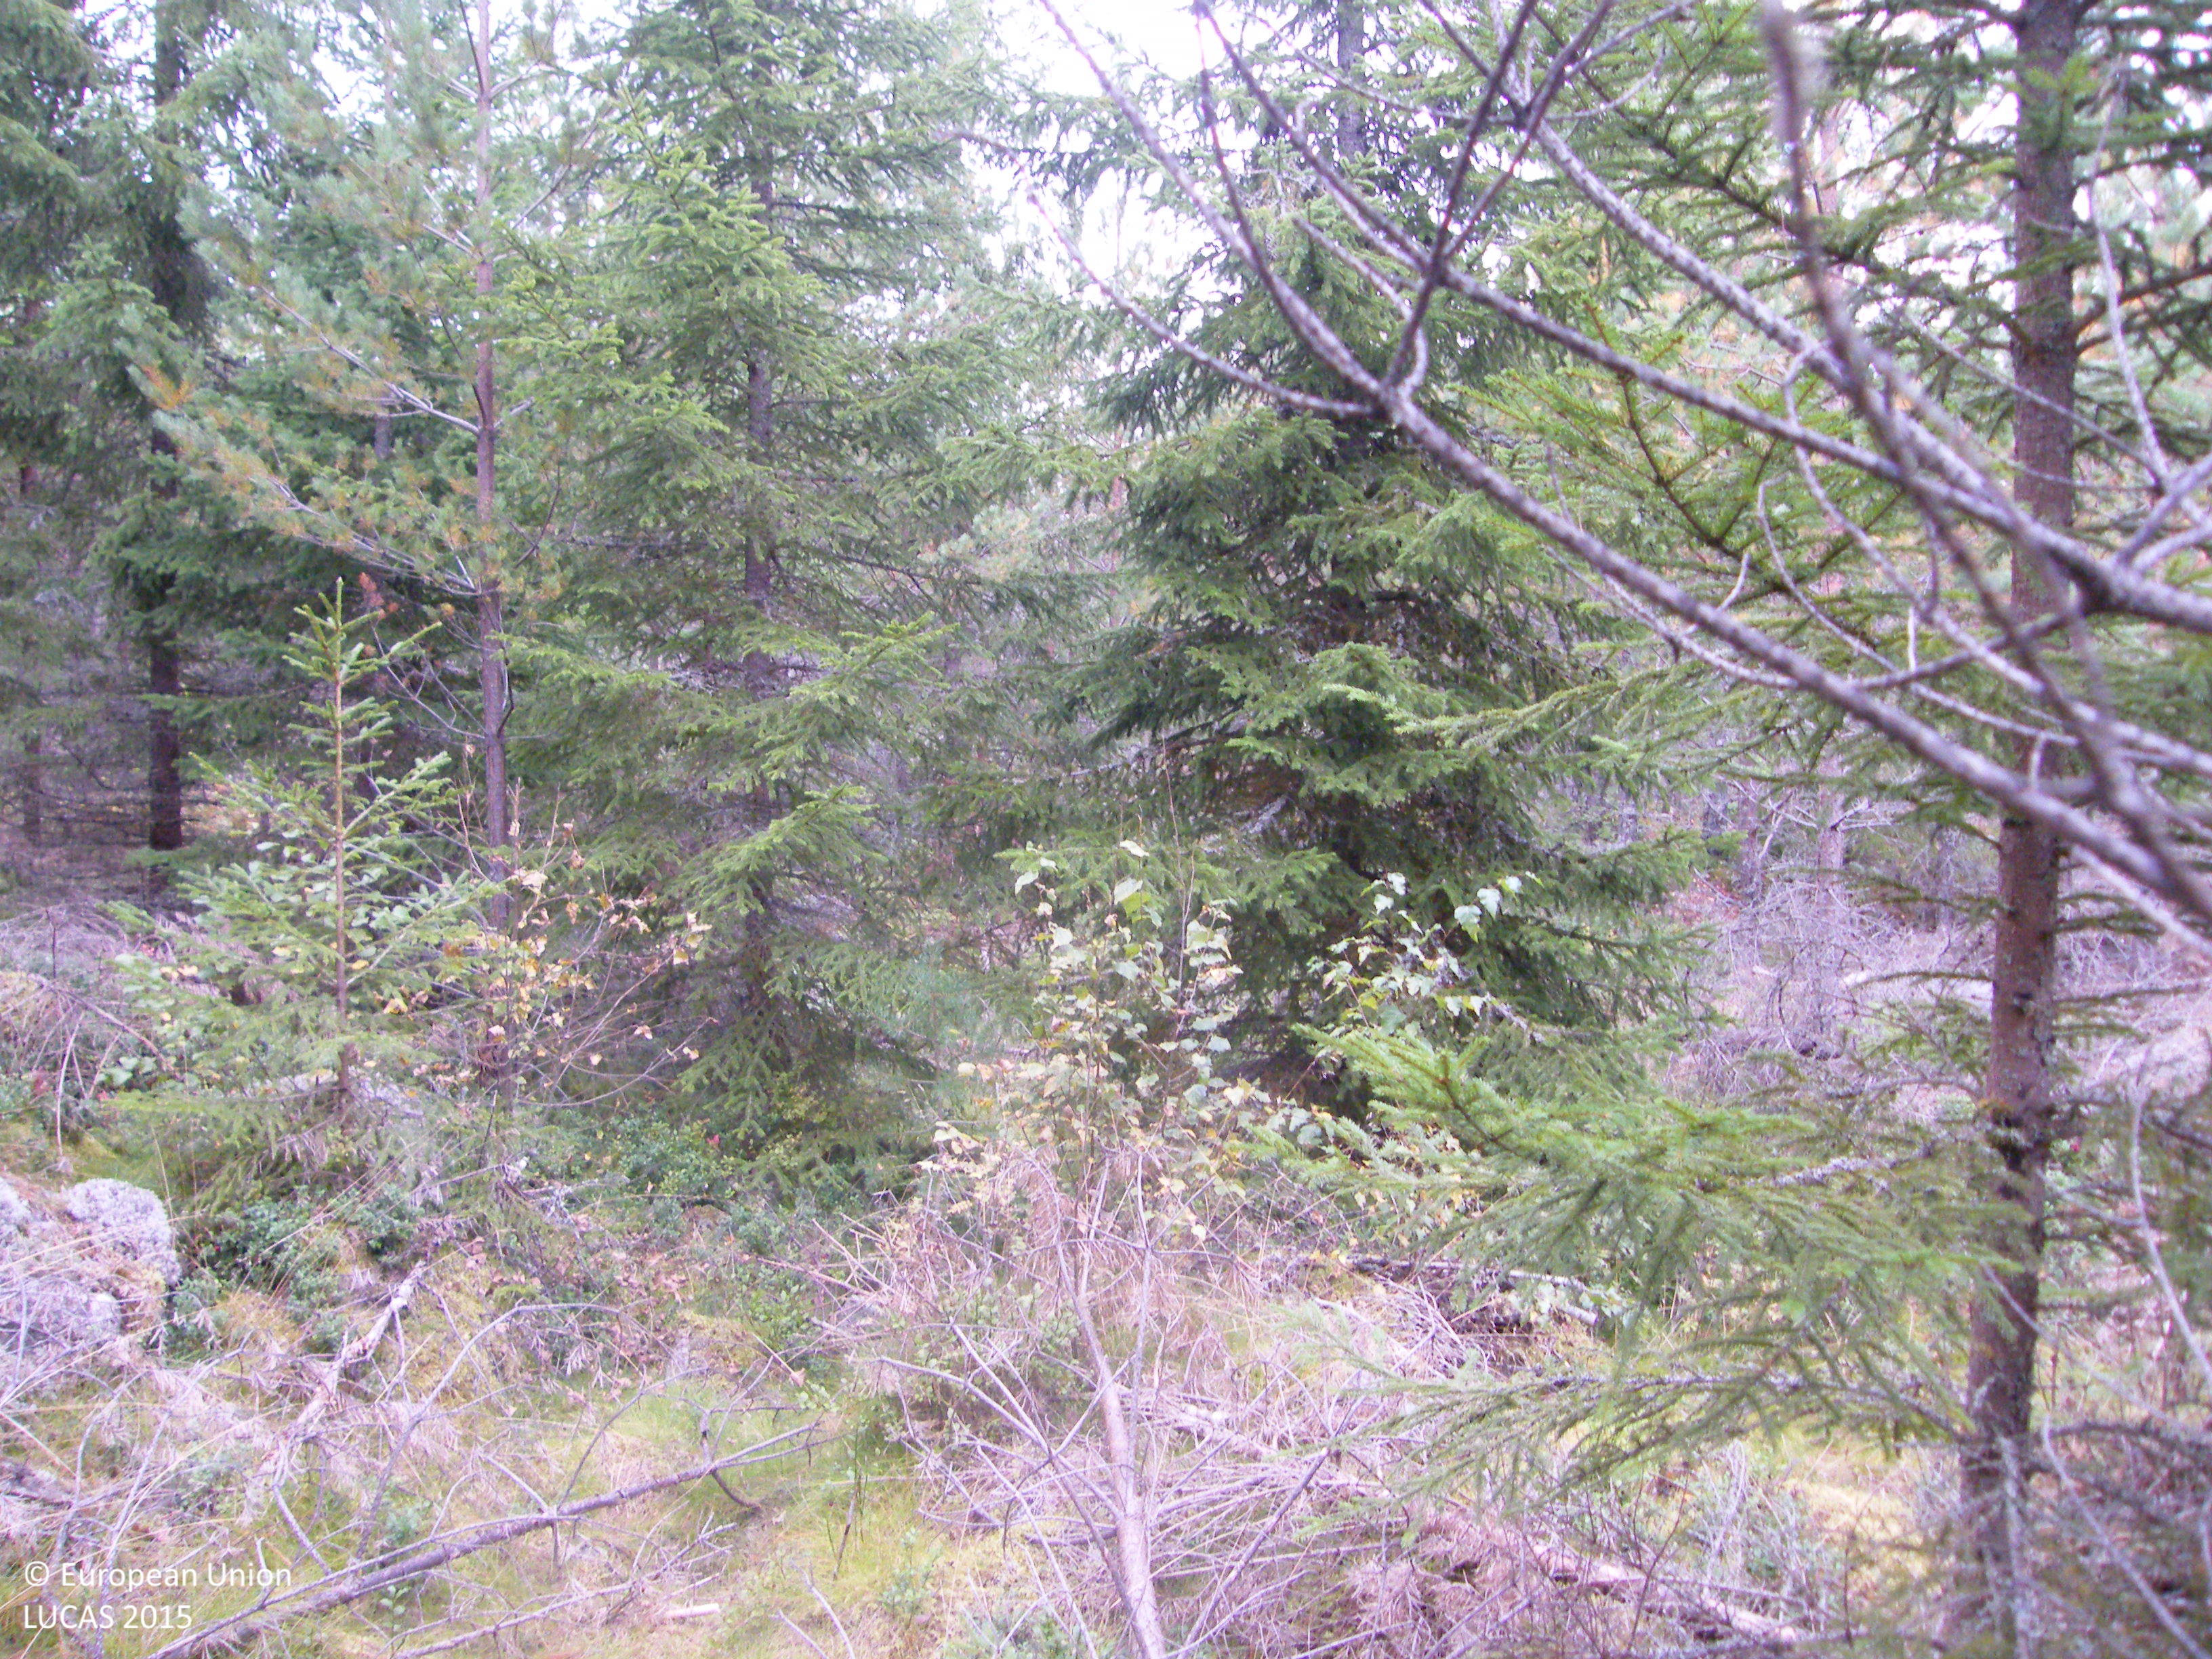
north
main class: Woodland
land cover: Pine dominated coniferous woodland
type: boreal forest
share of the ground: 50 - 75 %
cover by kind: coniferous forest trees 65 %, shrubs 20 %, lichens and mosses 10 %, broadleaved forest trees 5 %
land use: Forestry
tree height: > 5 m
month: September
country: SE
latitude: 59.5655
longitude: 15.5660
